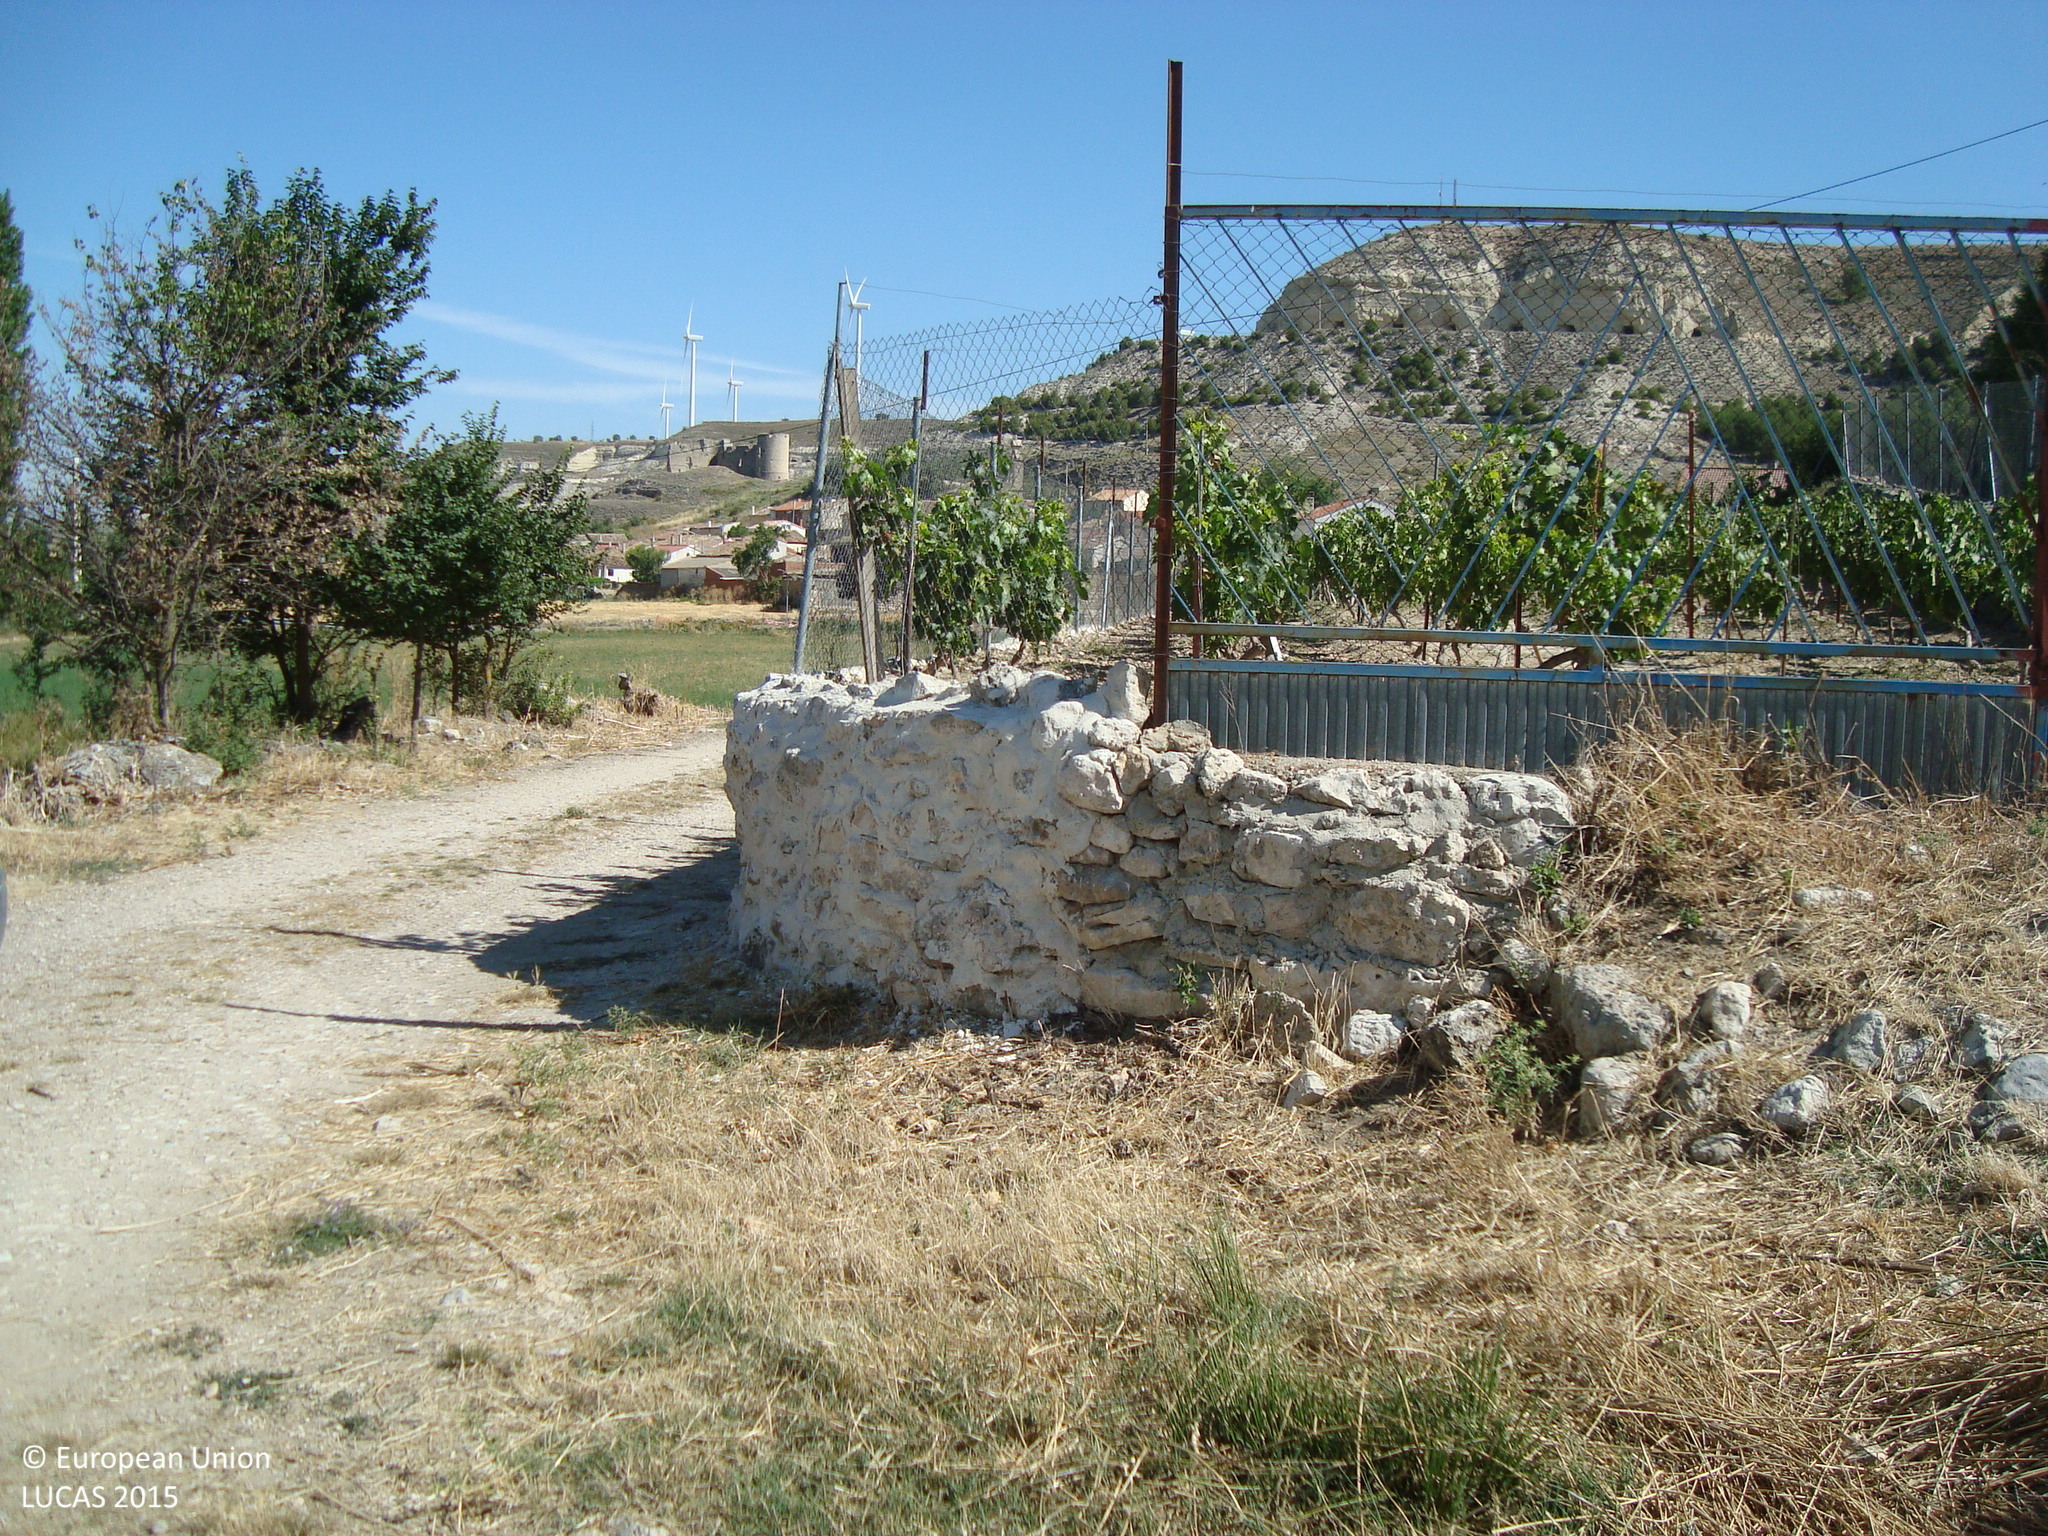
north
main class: Grassland
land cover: Grassland with sparse tree/shrub cover
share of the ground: 25 - 50 %
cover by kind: herbaceous plants 40 %, unconsolidated bare surface 10 %, broadleaved forest trees 5 %, shrubs 5 %
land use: Semi-natural and natural areas not in use
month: July
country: ES
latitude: 41.9854
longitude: -4.2719
